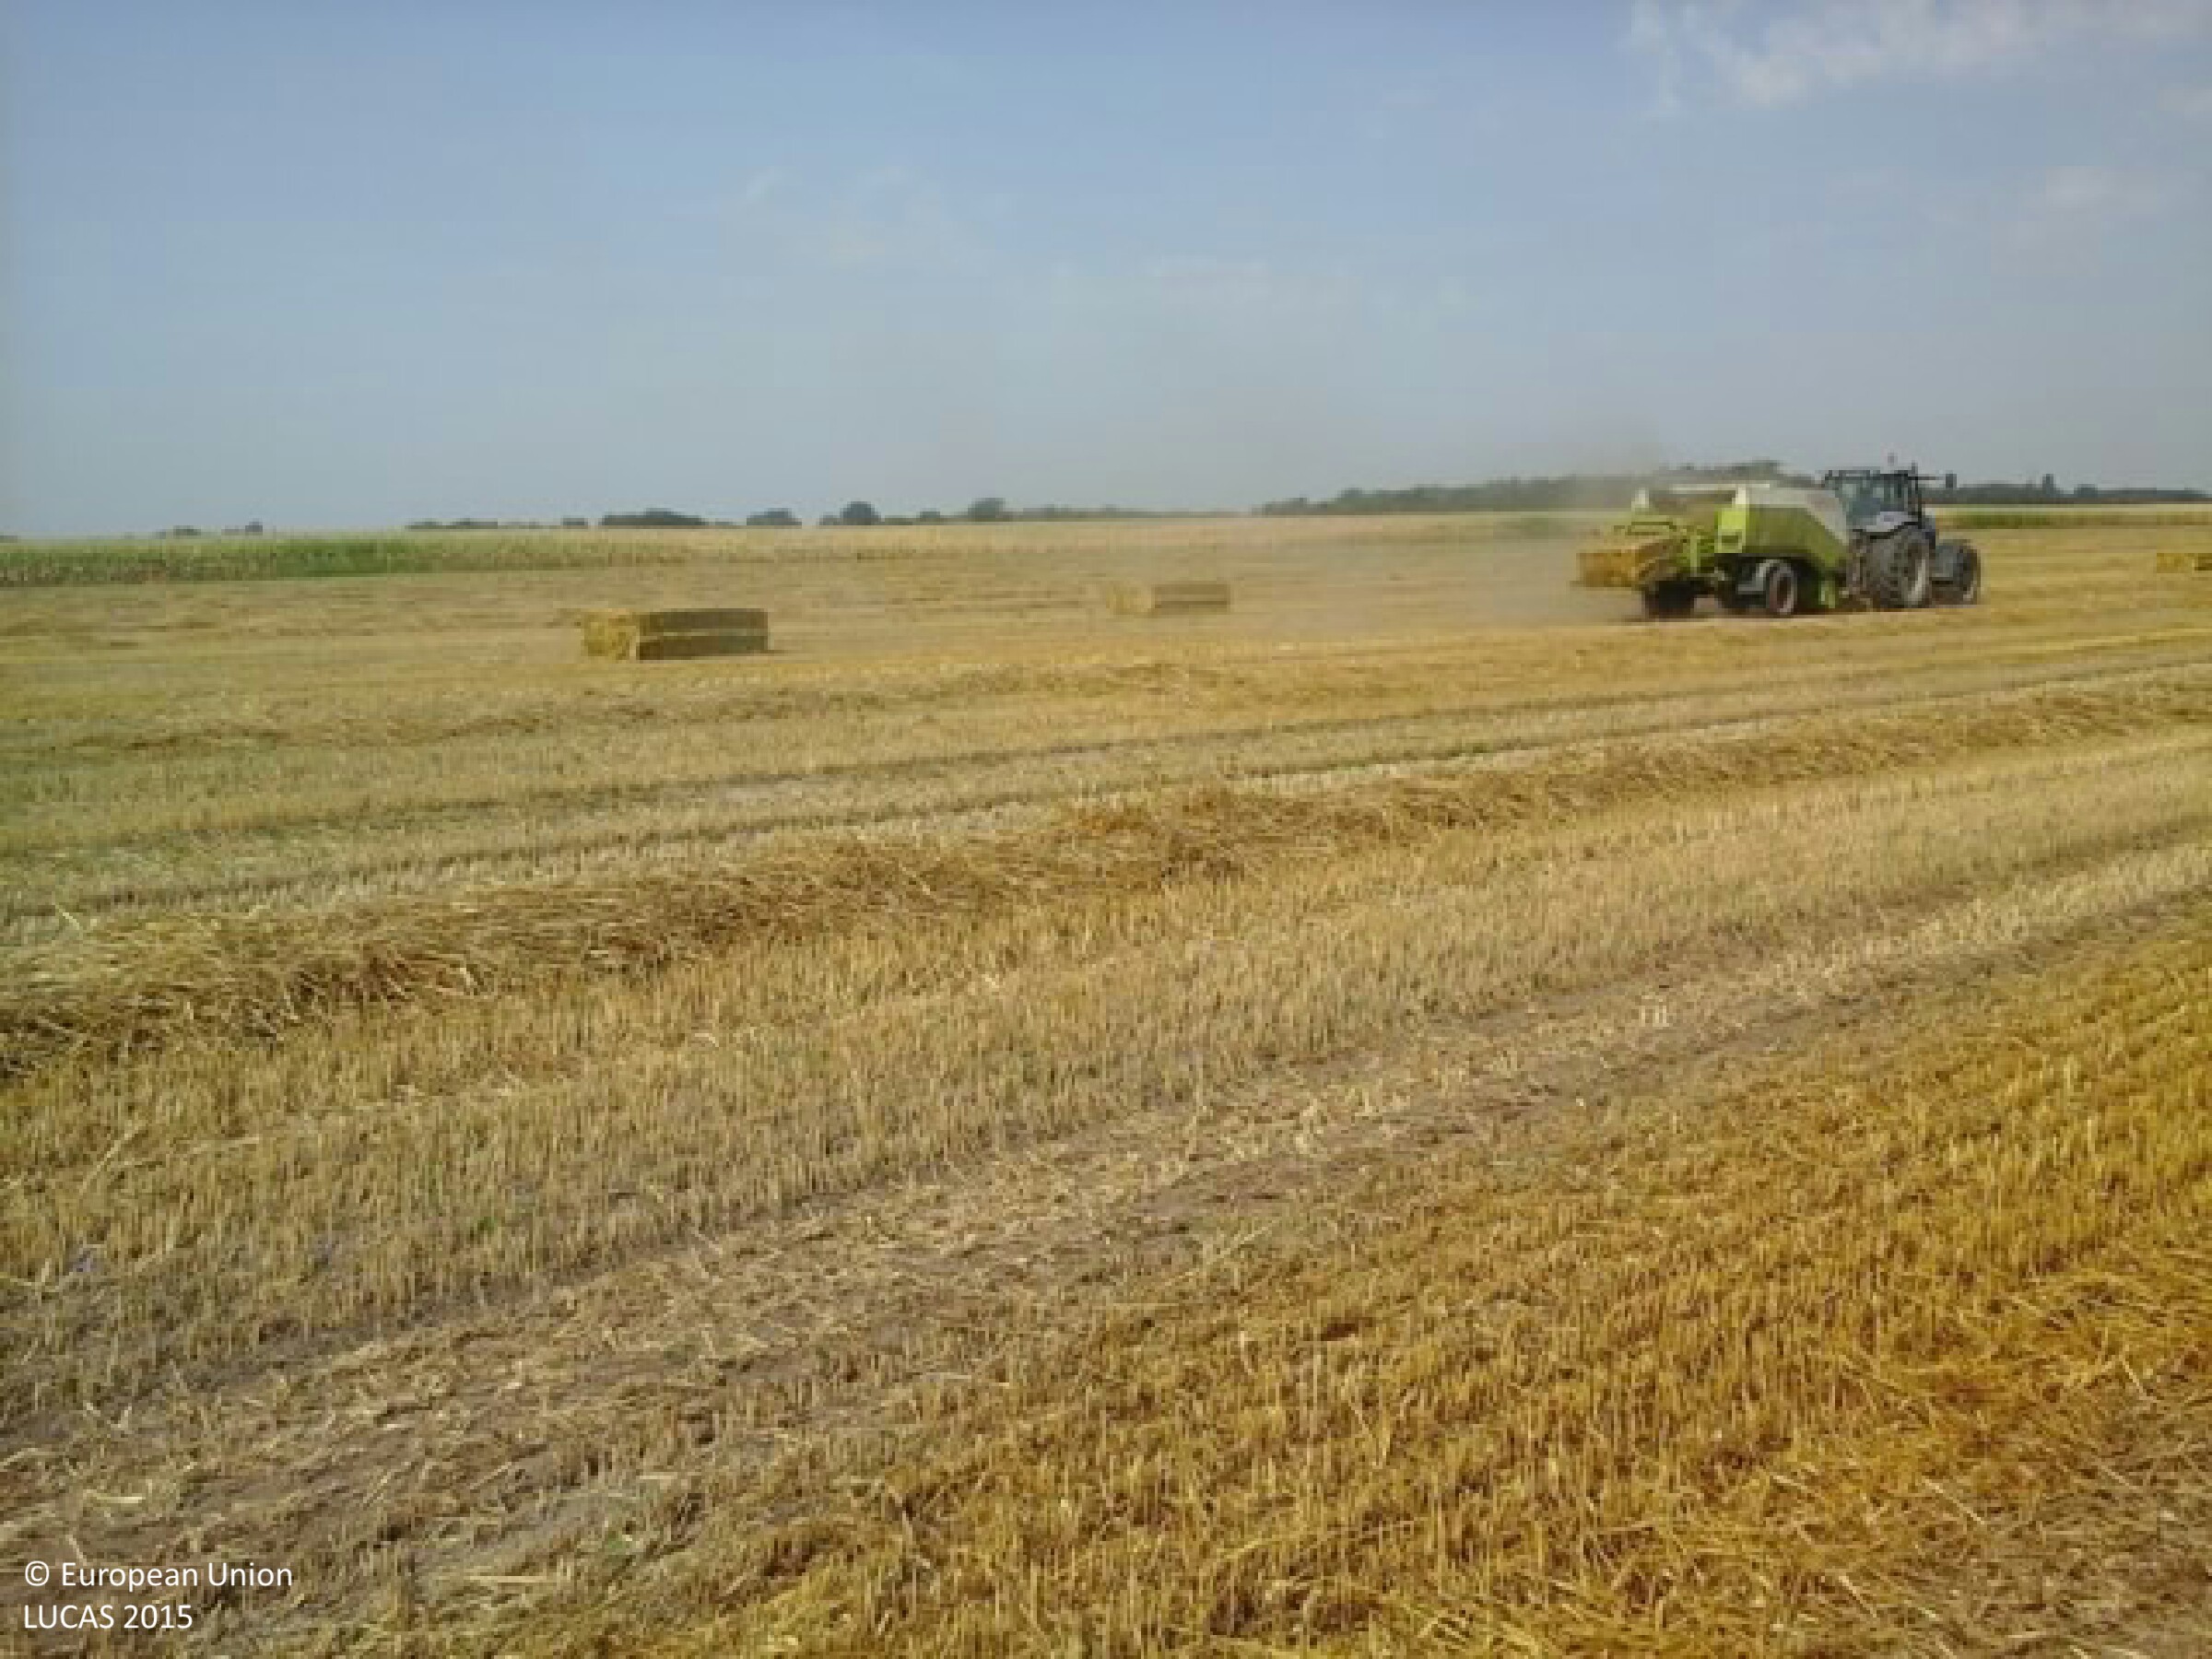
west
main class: Cropland
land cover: Common wheat
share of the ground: 25 - 50 %
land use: Agriculture (excluding fallow land and kitchen gardens)
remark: Harvested field
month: August
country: HU
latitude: 47.2359
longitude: 19.0387
